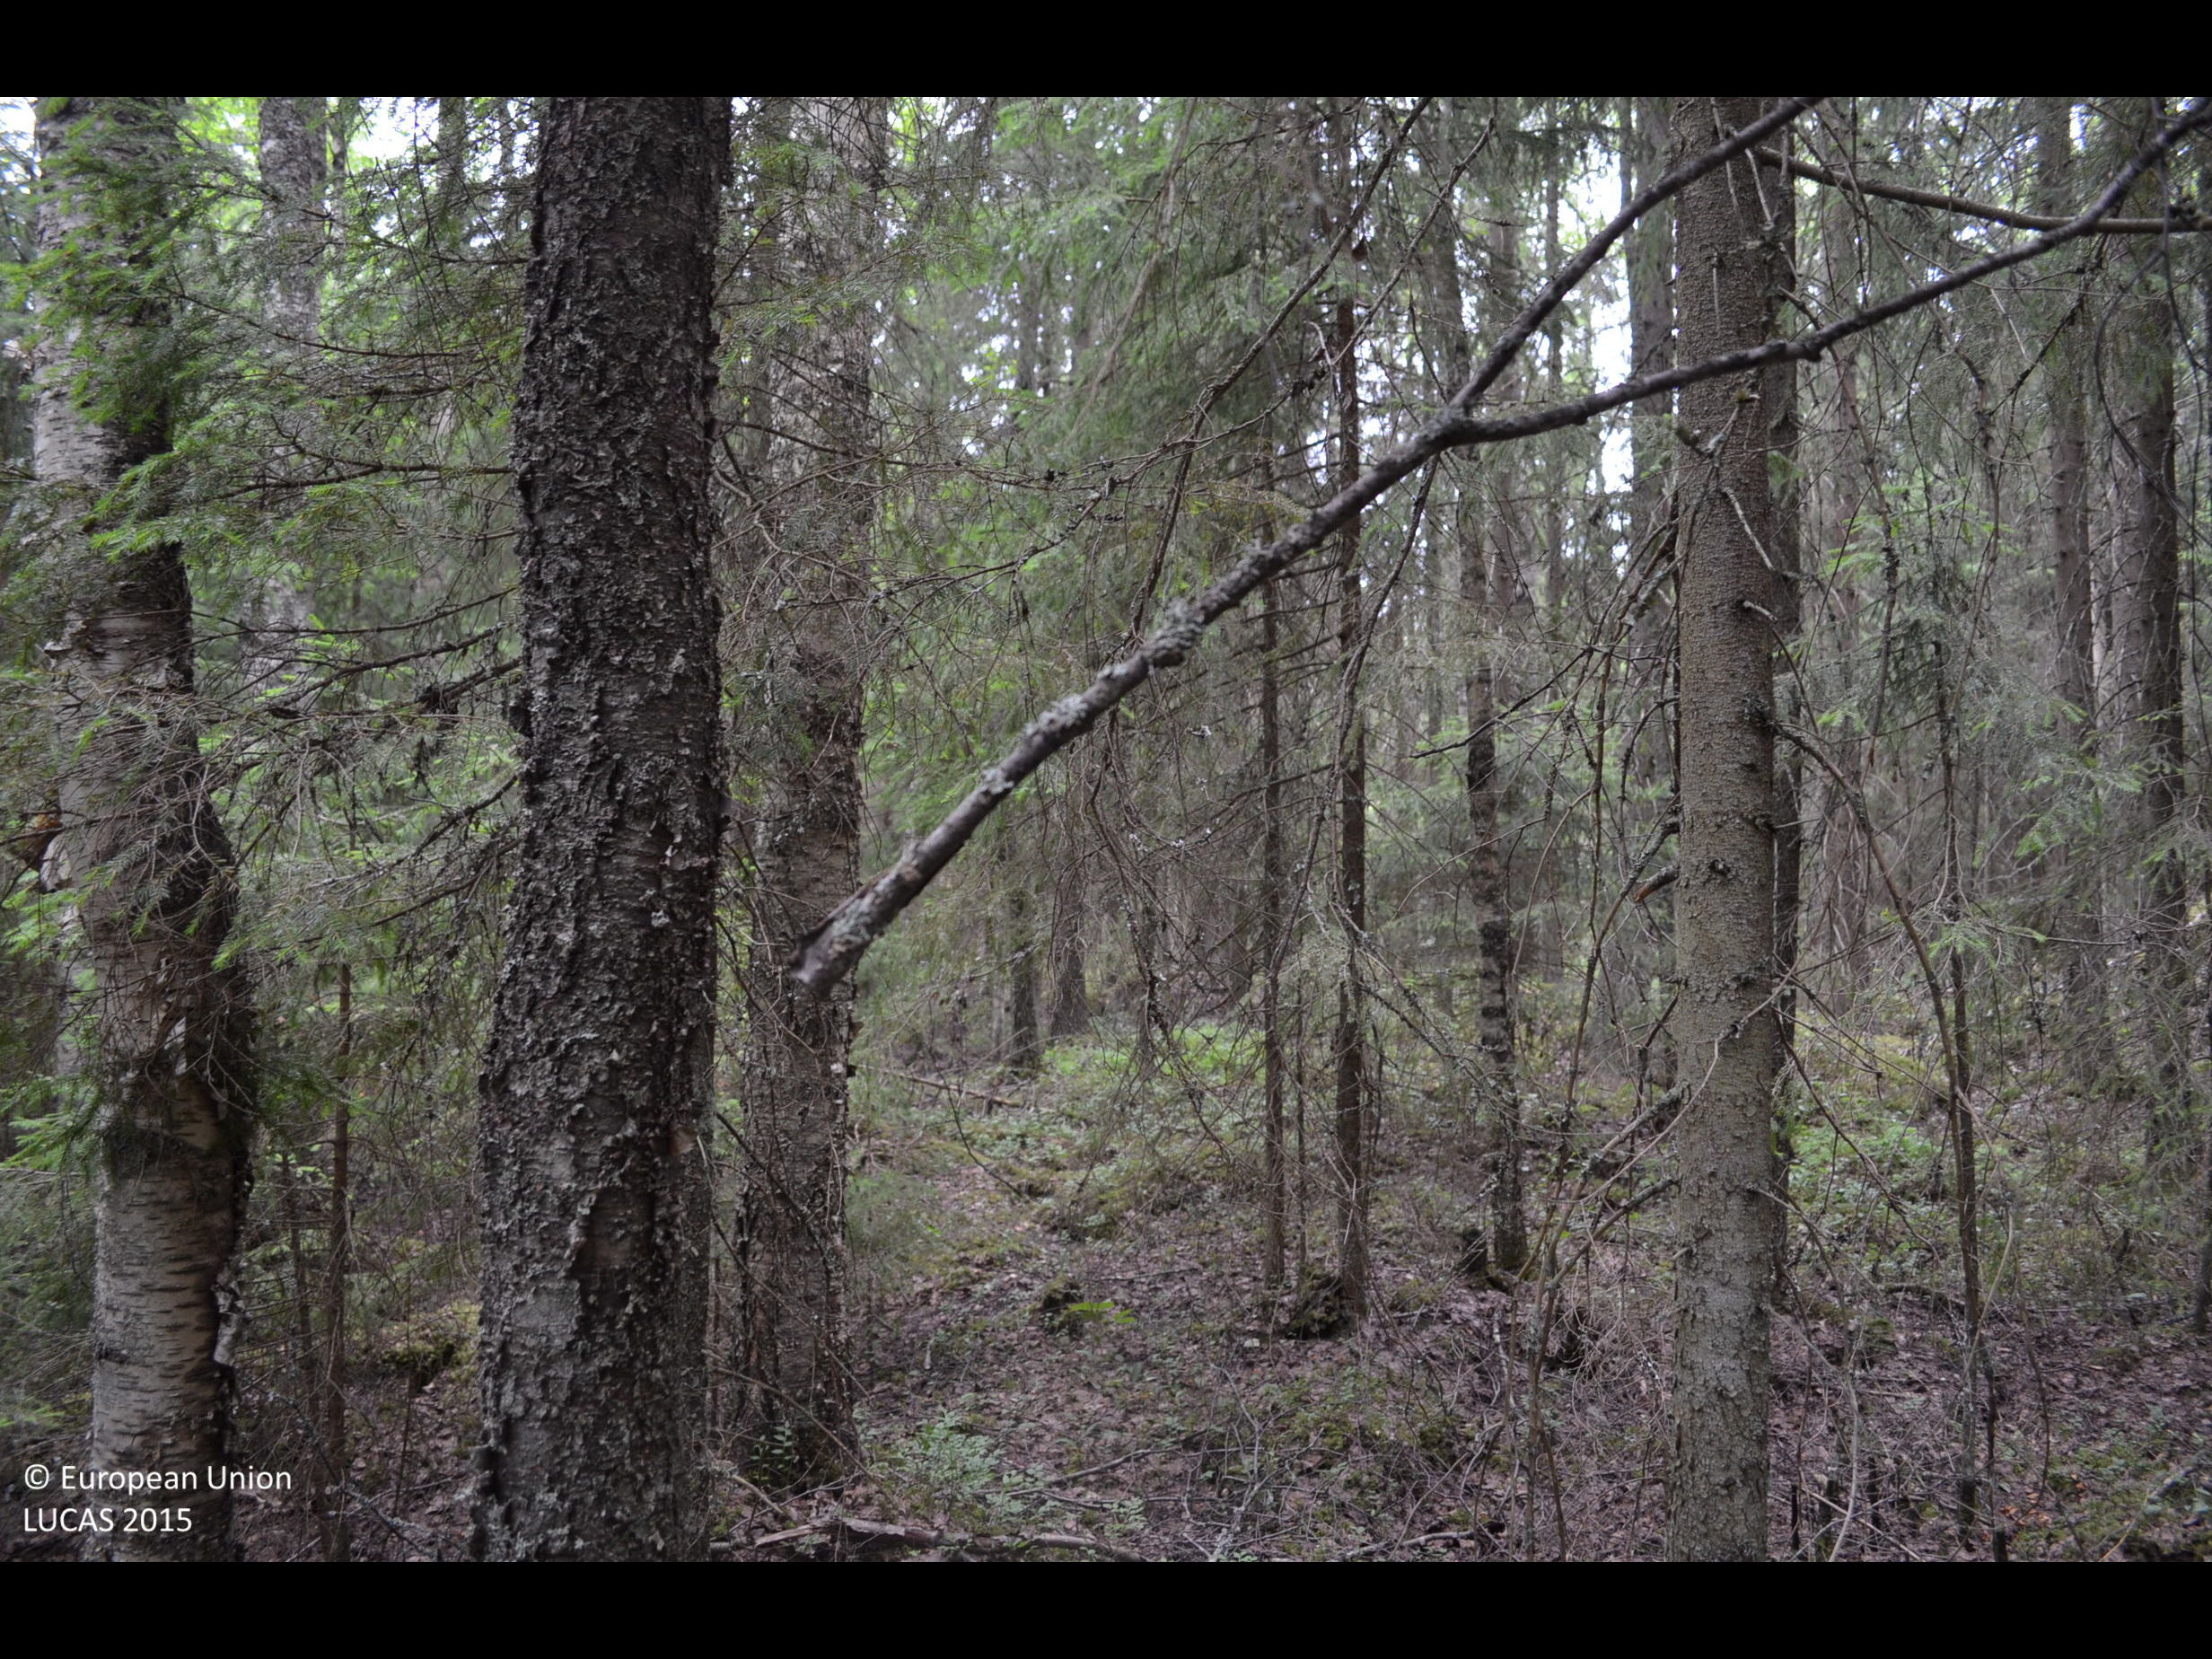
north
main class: Woodland
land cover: Spruce dominated mixed woodland
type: boreal forest
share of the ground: > 75 %
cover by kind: broadleaved forest trees 50 %, coniferous forest trees 45 %, shrubs 5 %
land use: Forestry
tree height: > 5 m
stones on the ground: < 10 %
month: July
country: FI
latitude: 61.6163
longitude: 23.2938
